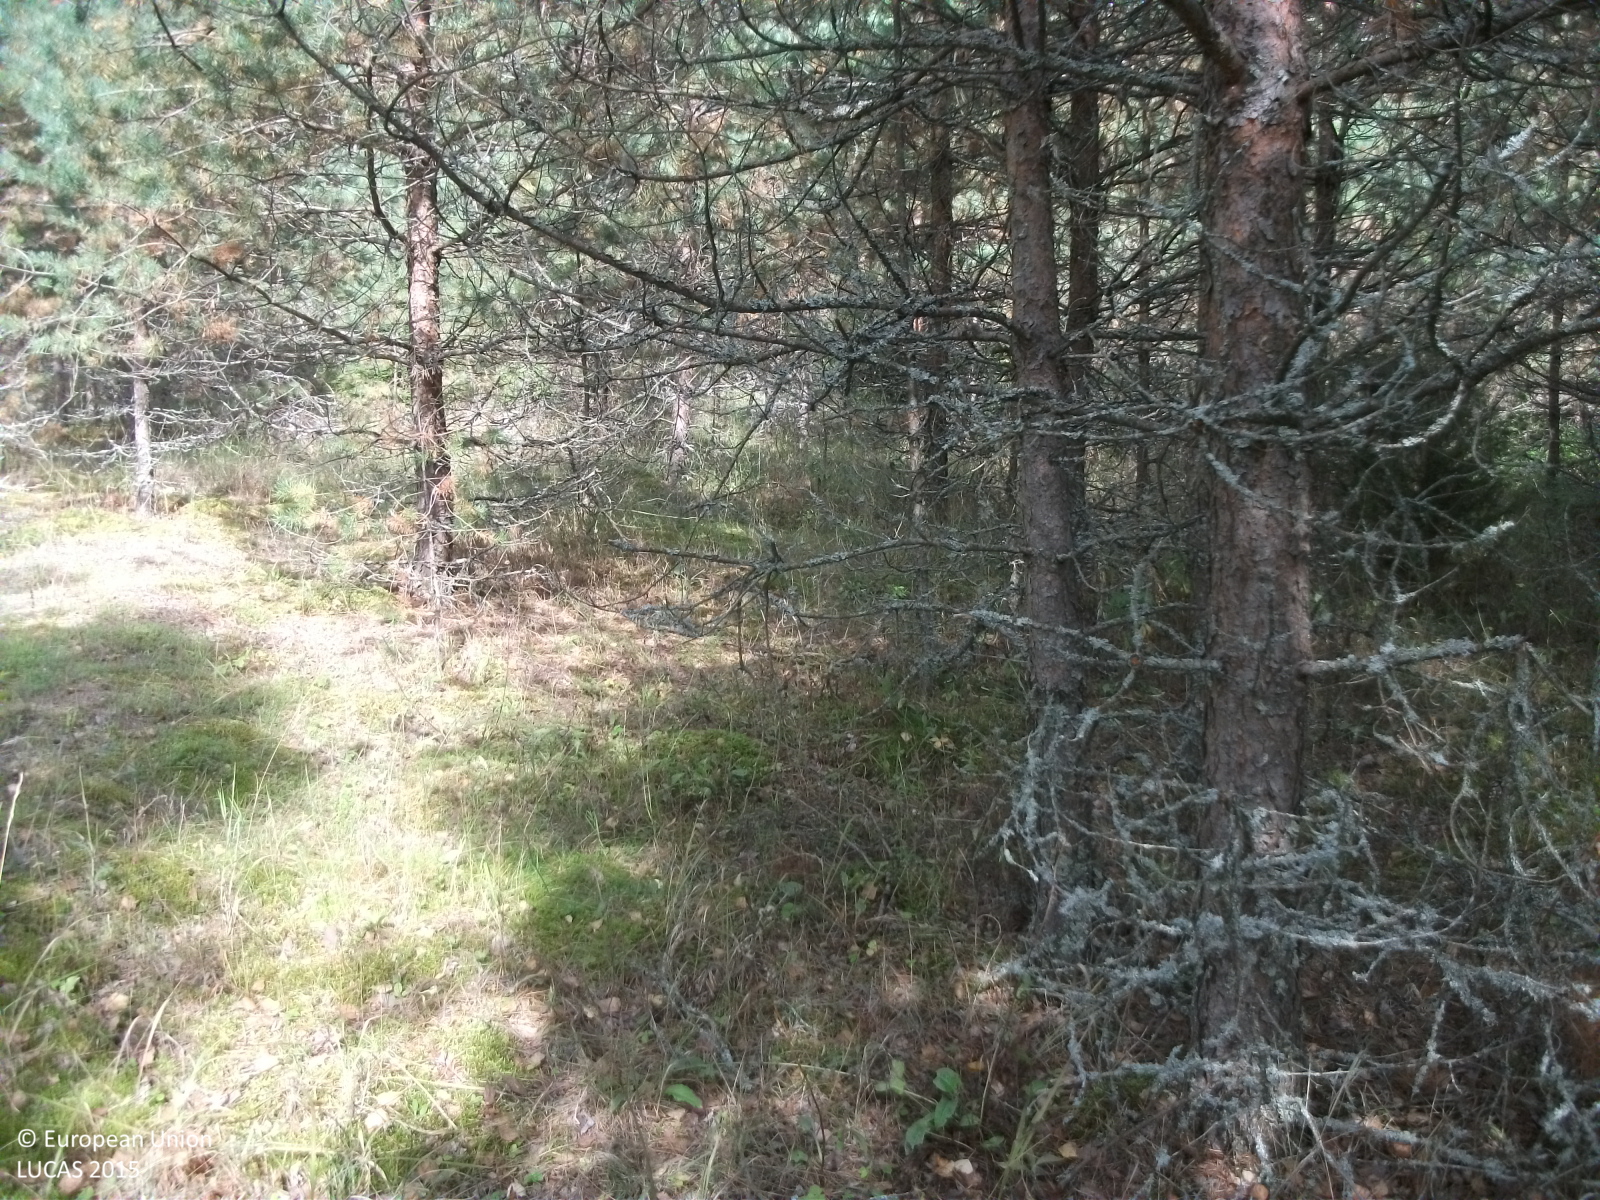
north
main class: Woodland
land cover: Pine dominated coniferous woodland
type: hemiboreal forest and nemoral coniferous forest and mixed broadleaved-coniferous forest
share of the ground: 50 - 75 %
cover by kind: coniferous forest trees 70 %, lichens and mosses 25 %, herbaceous plants 5 %
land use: Forestry
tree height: > 5 m
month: September
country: LV
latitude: 56.5760
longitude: 26.1047
